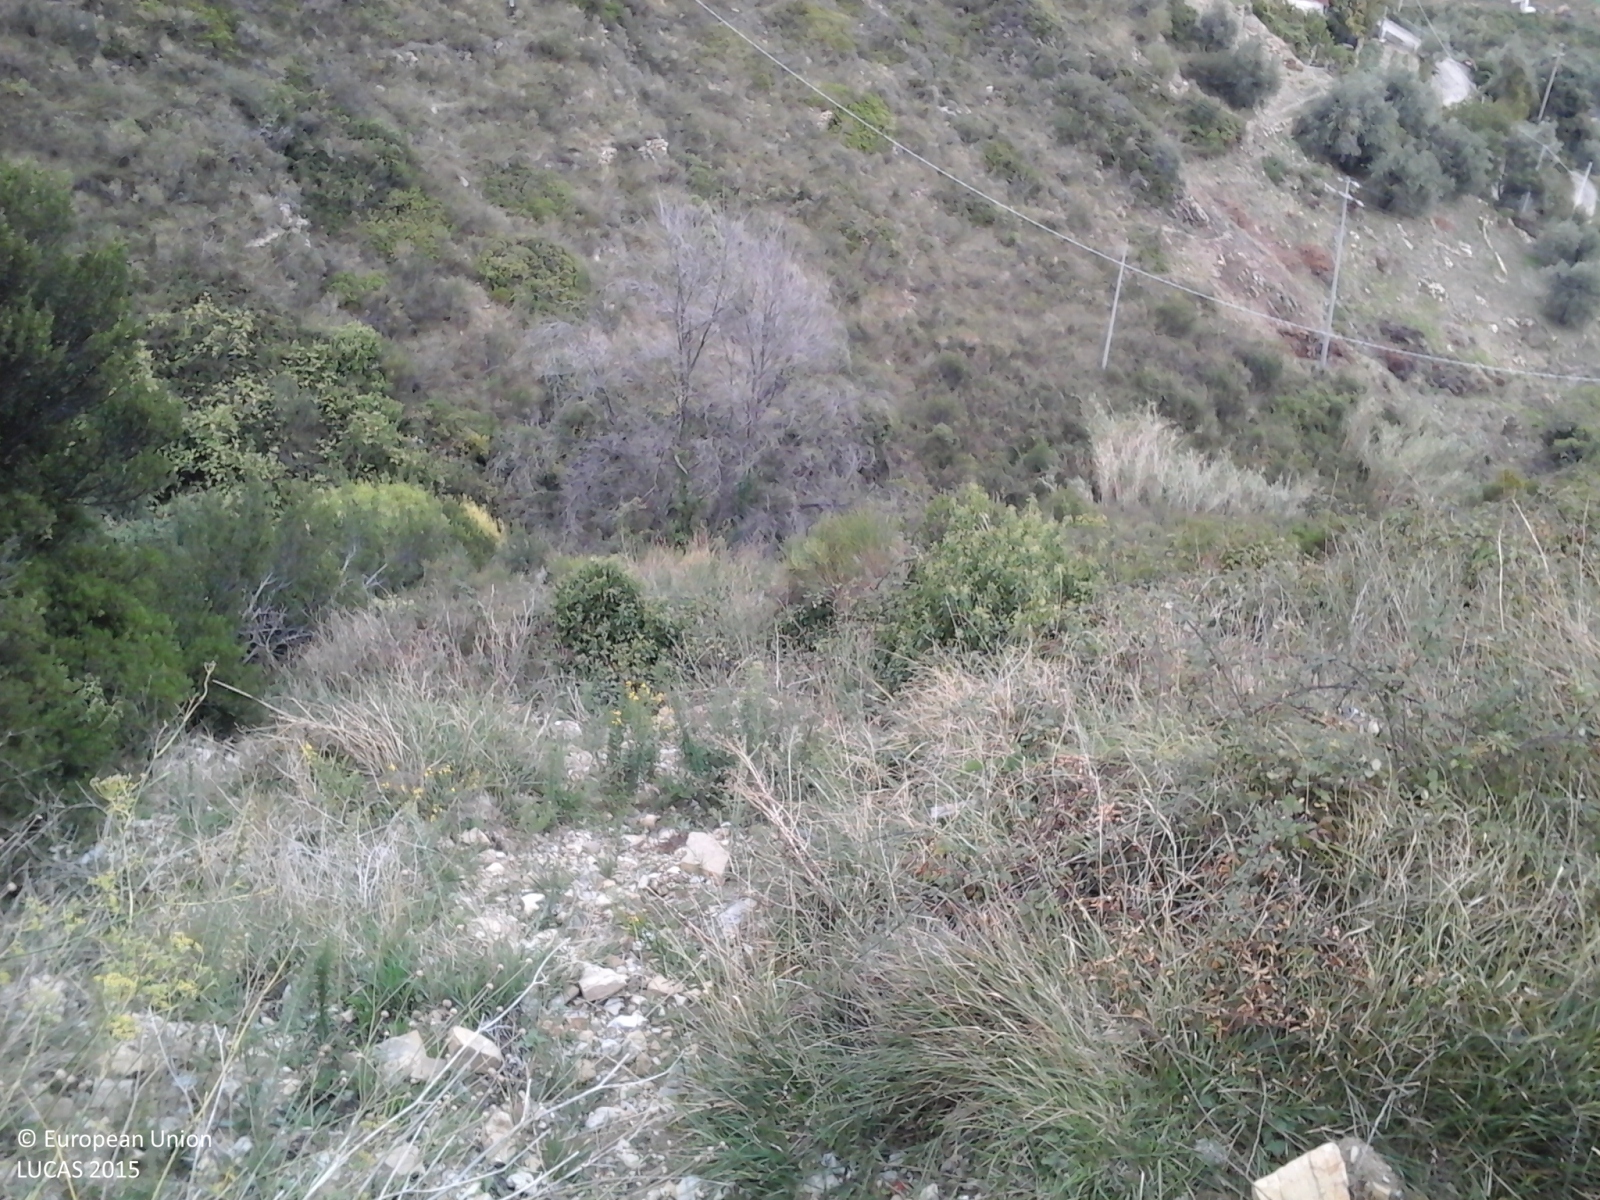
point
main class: Shrubland
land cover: Shrubland with sparse tree cover
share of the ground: > 75 %
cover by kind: shrubs 60 %, herbaceous plants 30 %, broadleaved forest trees 5 %, consolidated bare surface 5 %
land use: Semi-natural and natural areas not in use
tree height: > 5 m
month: October
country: IT
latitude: 43.8205
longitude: 7.7303
